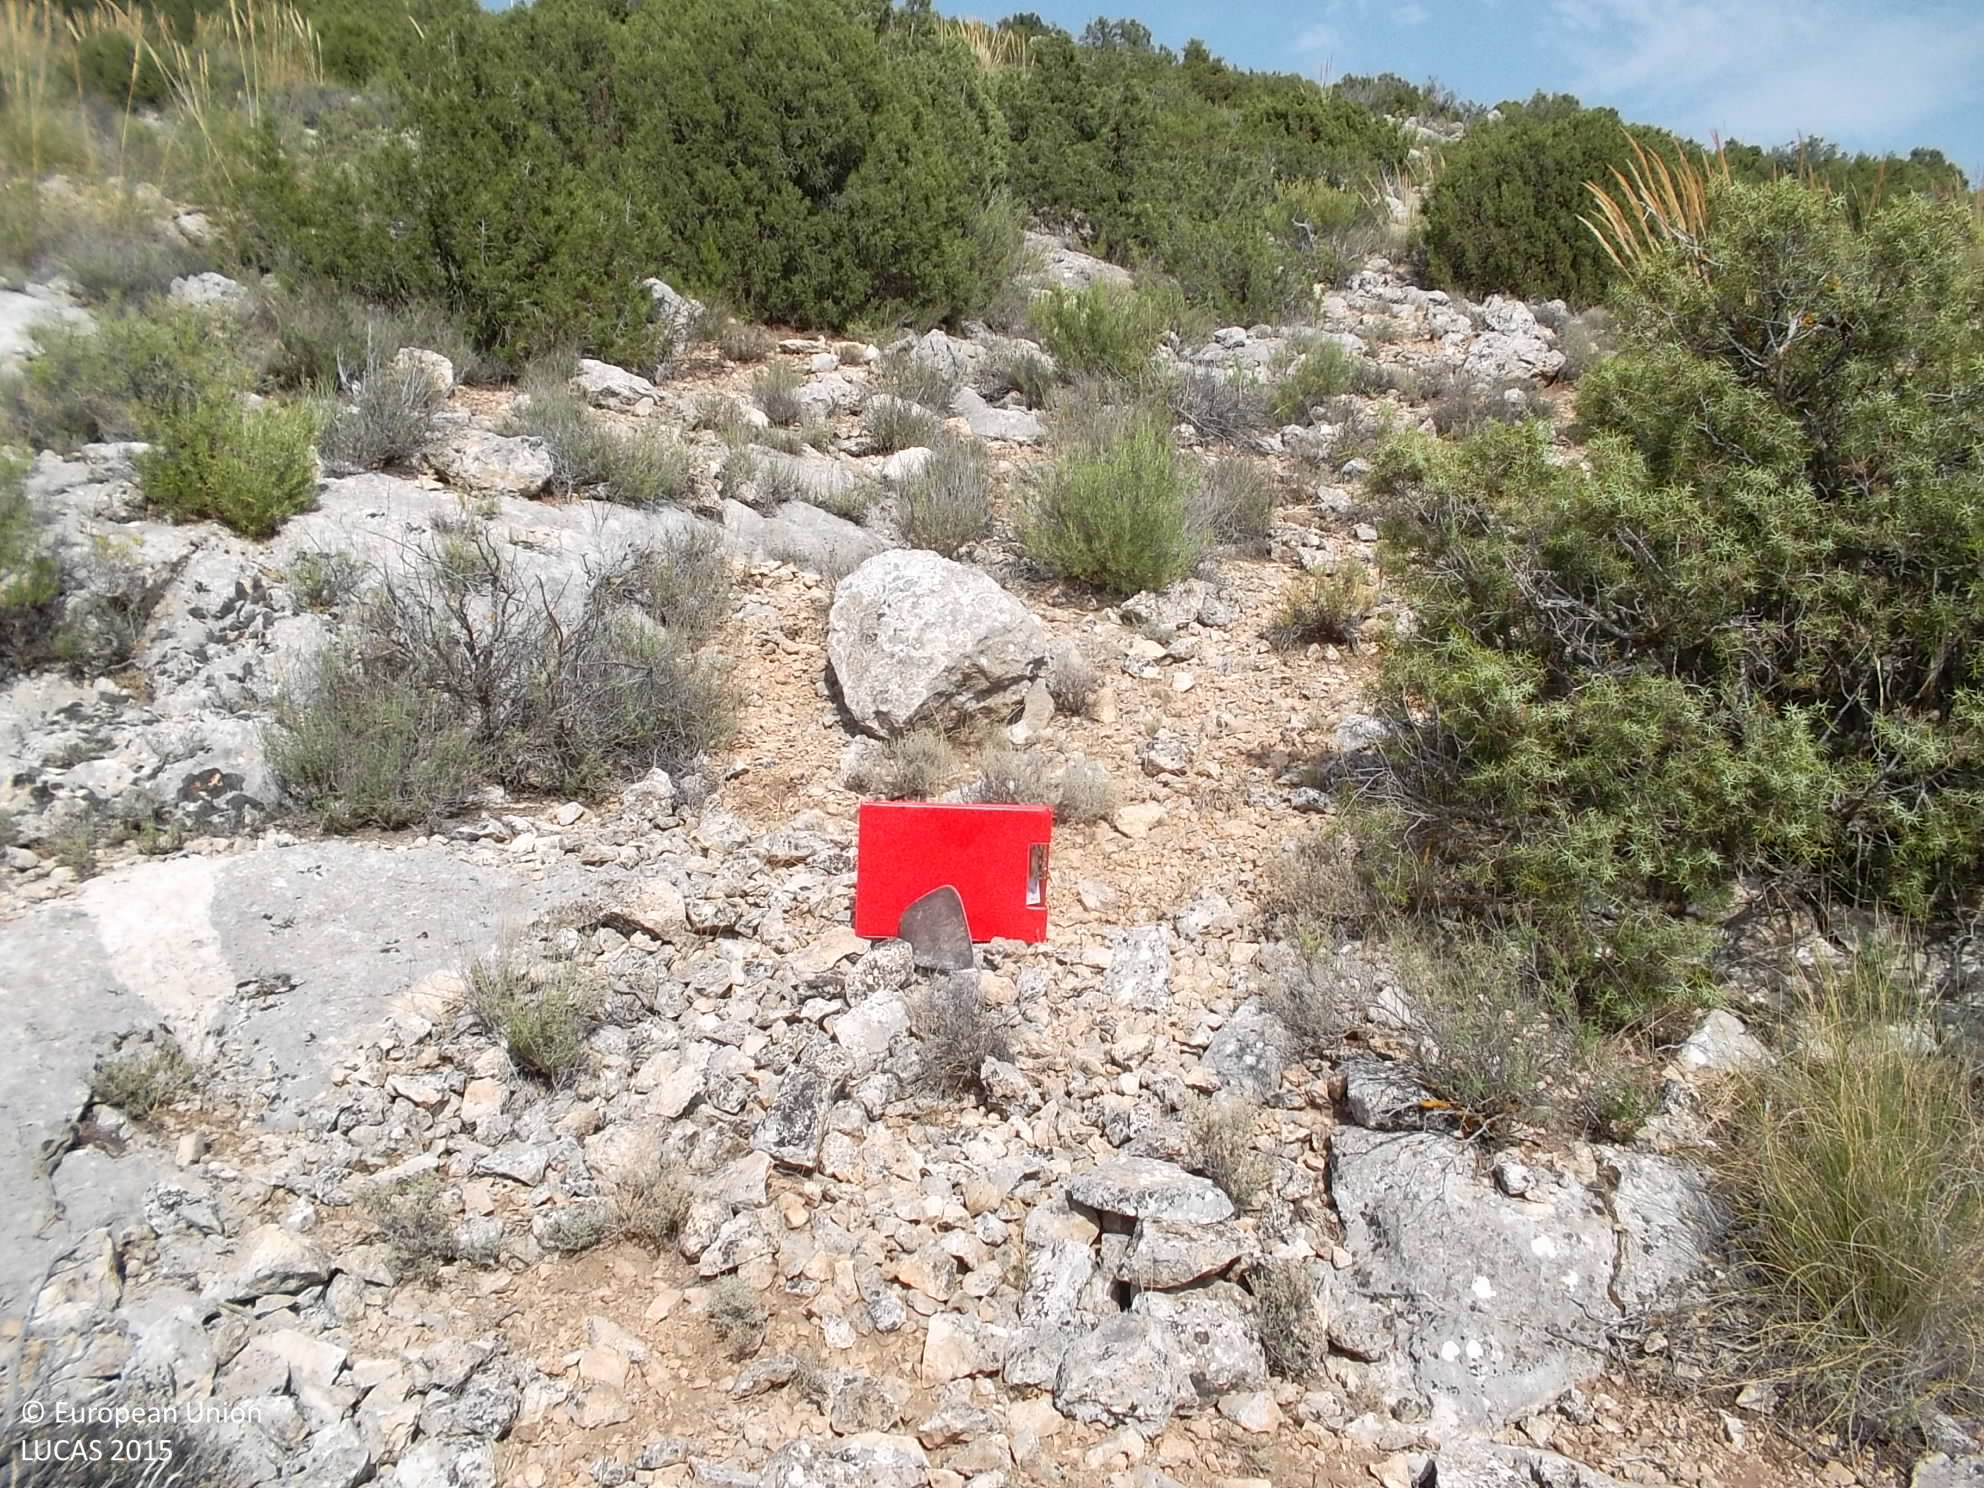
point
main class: Shrubland
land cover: Shrubland without tree cover
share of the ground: 50 - 75 %
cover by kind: shrubs 60 %, herbaceous plants 20 %, consolidated bare surface 20 %
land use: Semi-natural and natural areas not in use
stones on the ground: 25 - 50 %
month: July
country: ES
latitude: 37.8980
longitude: -2.4430
